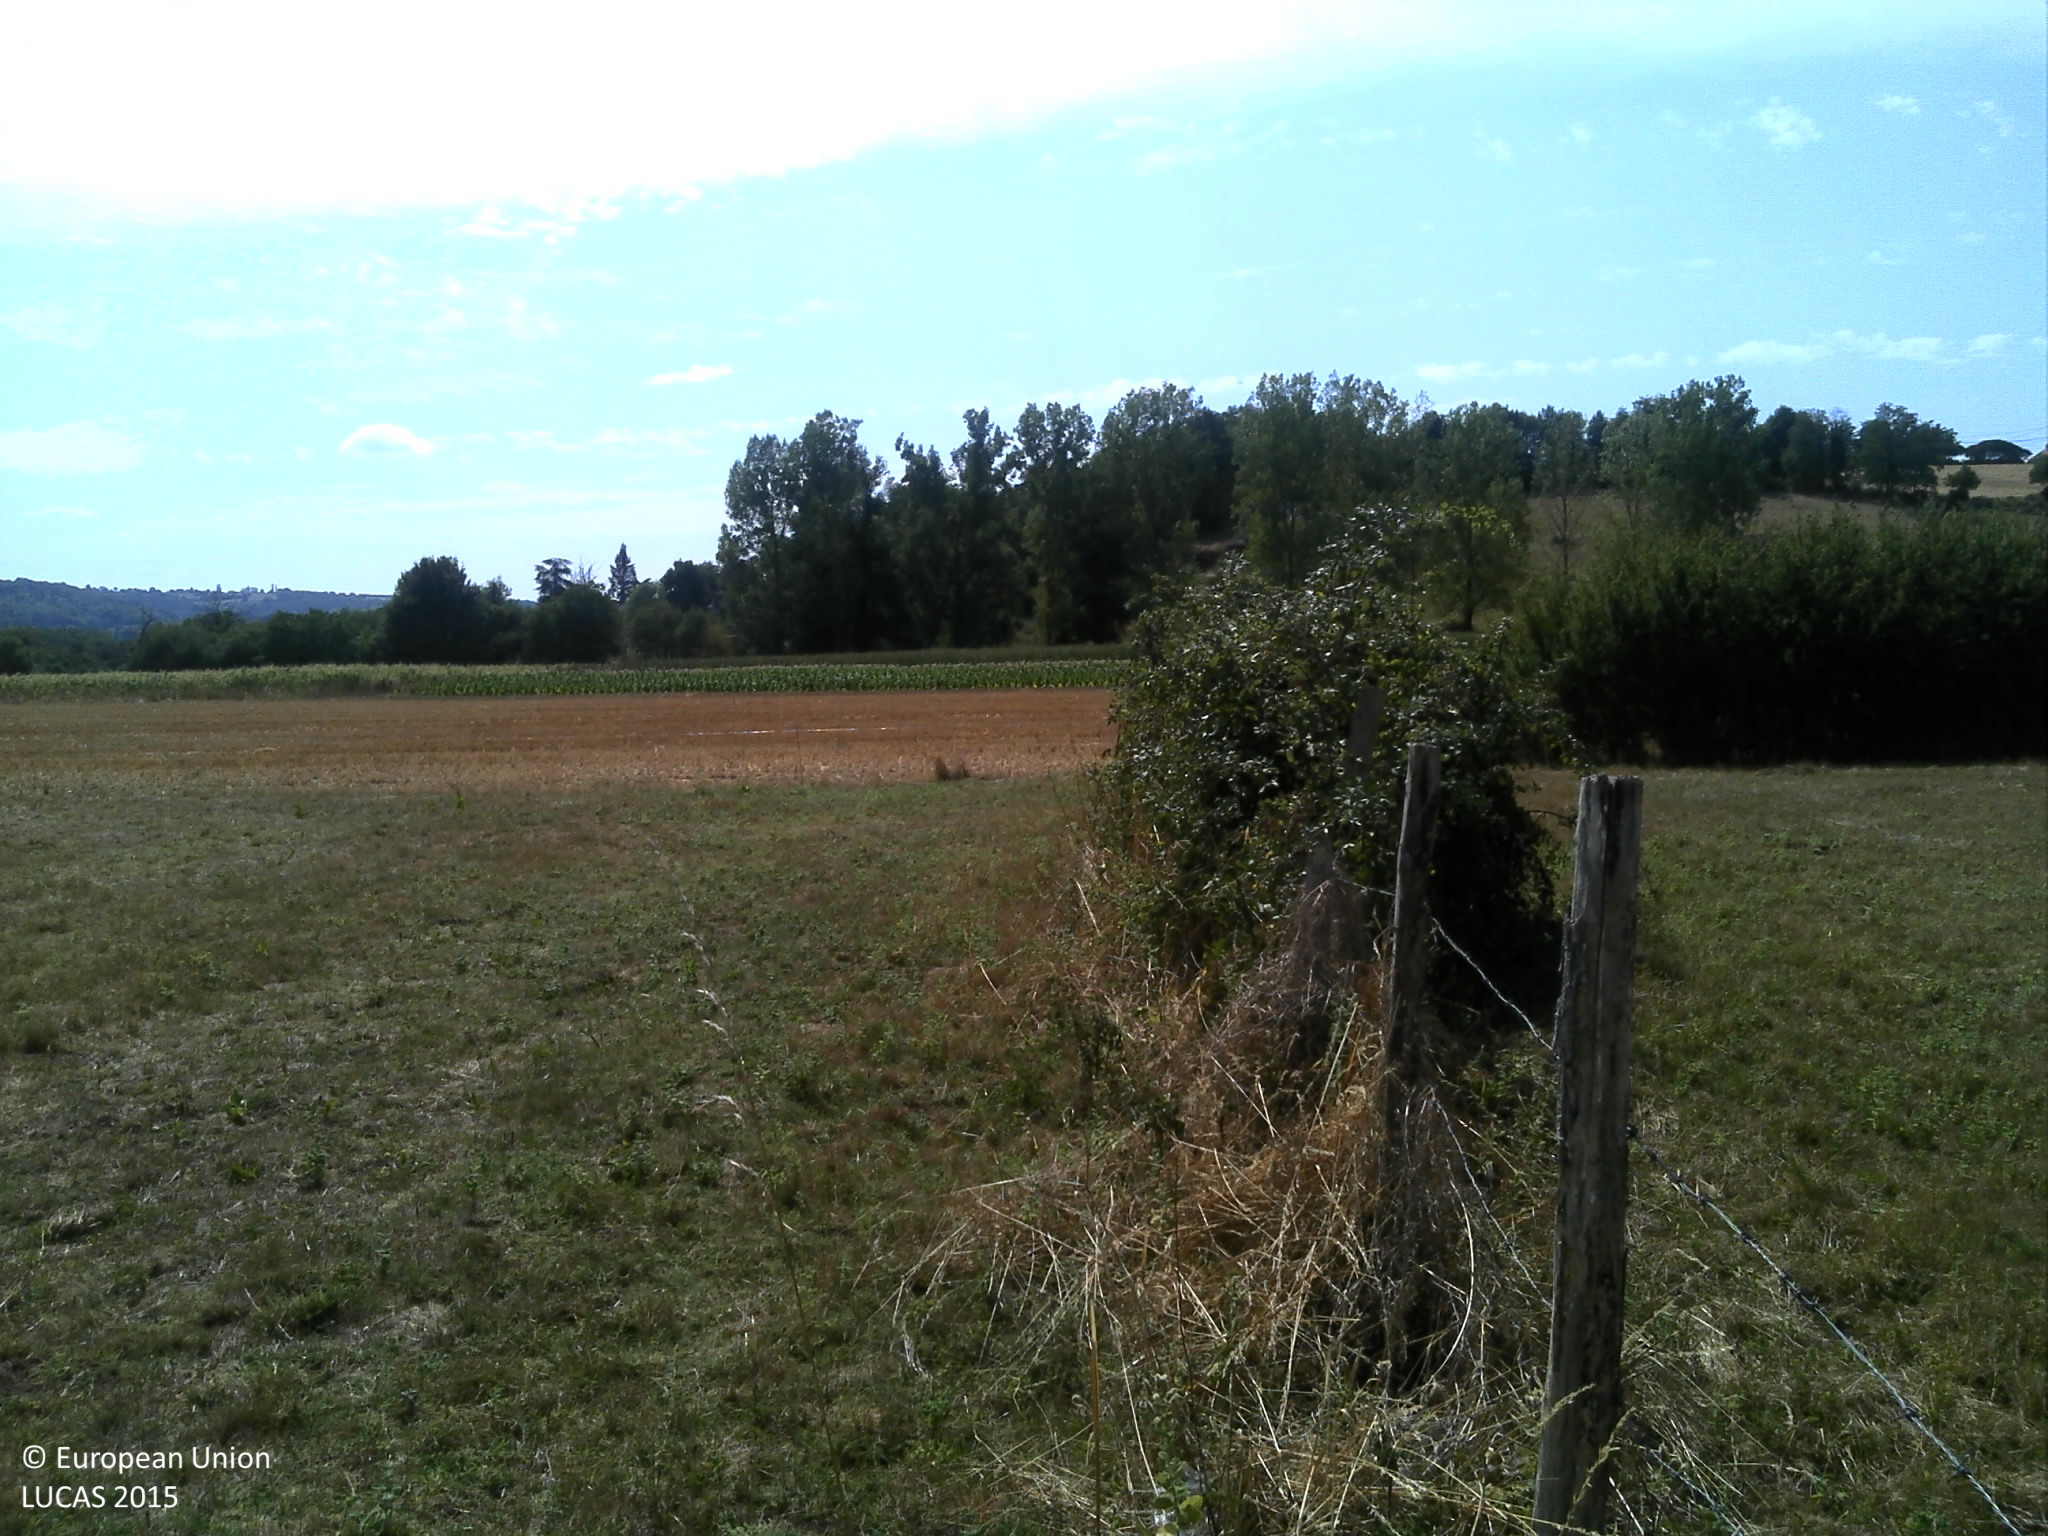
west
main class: Grassland
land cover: Grassland without tree/shrub cover
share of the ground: > 75 %
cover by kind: herbaceous plants 100 %
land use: Agriculture (excluding fallow land and kitchen gardens)
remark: Harvested field
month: July
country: FR
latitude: 45.1358
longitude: 1.4115
